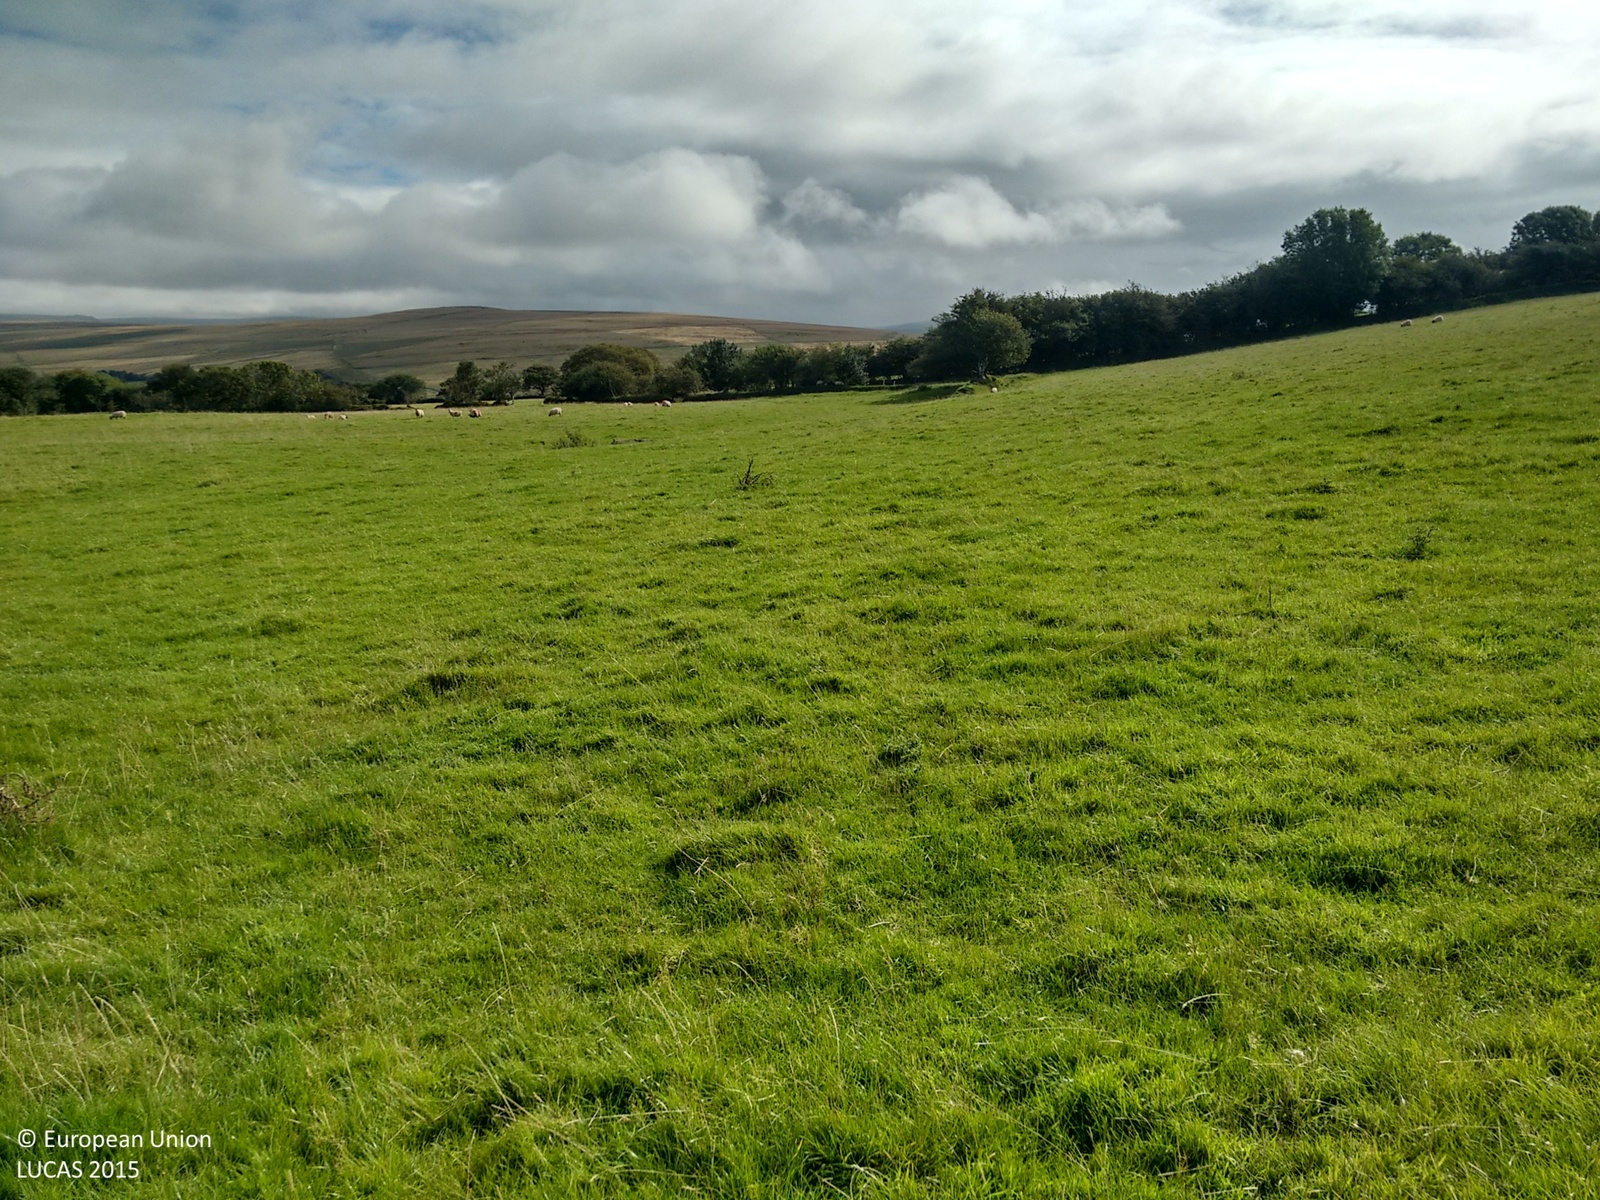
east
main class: Grassland
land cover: Grassland without tree/shrub cover
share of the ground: > 75 %
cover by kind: herbaceous plants 100 %
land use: Agriculture (excluding fallow land and kitchen gardens)
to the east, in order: Grassland without tree/shrub cover; Managed hedges; Grassland without tree/shrub cover
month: September
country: GB
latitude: 50.6099
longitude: -4.1577
